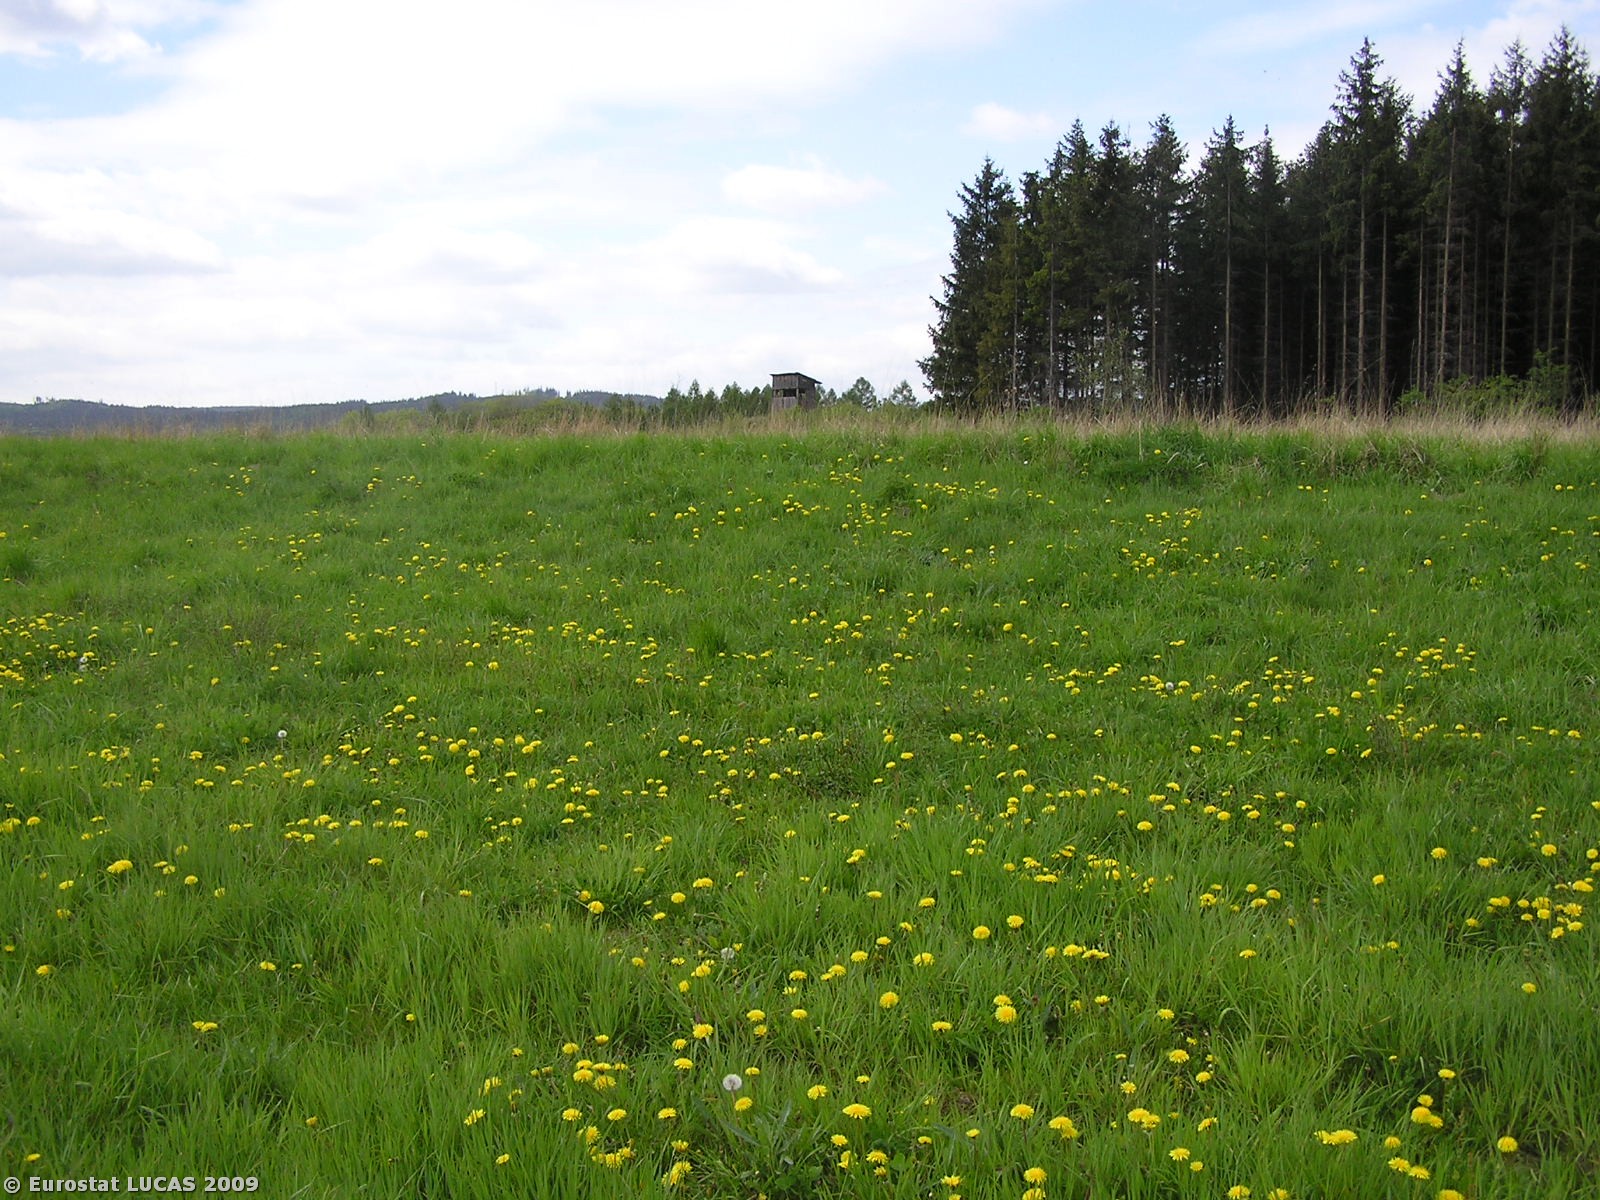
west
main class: Grassland
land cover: Grassland without tree/shrub cover
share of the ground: > 75 %
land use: Agriculture (excluding fallow land and kitchen gardens)
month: May
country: CZ
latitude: 49.9837
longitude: 17.6138
